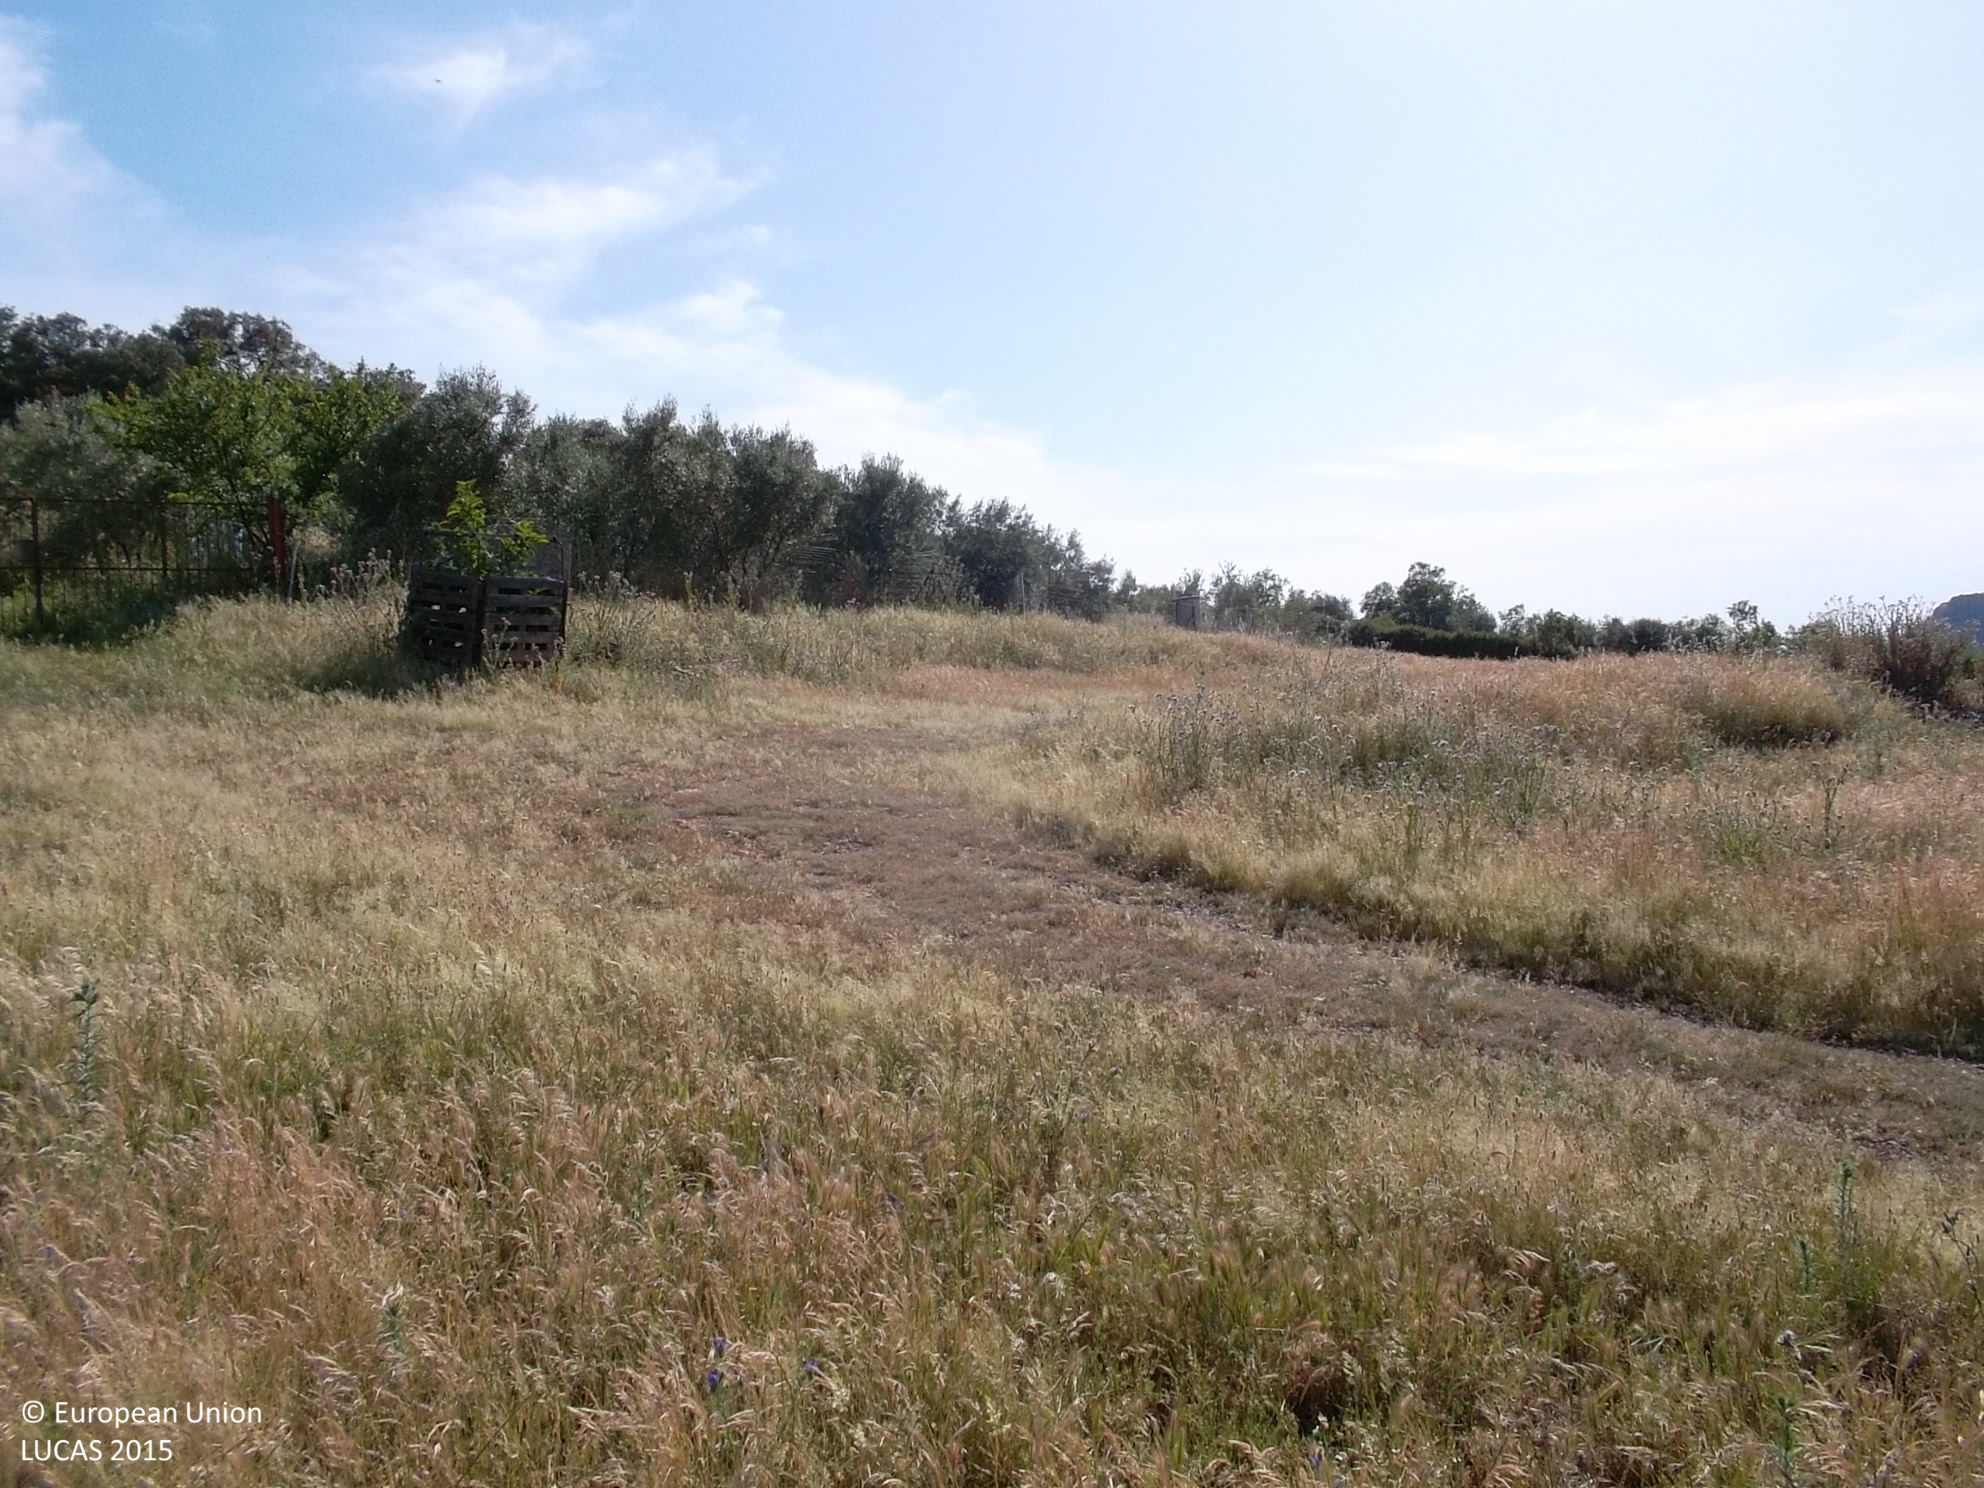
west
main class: Grassland
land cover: Grassland without tree/shrub cover
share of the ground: > 75 %
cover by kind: herbaceous plants 100 %
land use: Agriculture (excluding fallow land and kitchen gardens)
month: May
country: ES
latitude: 38.7677
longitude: -4.8185
